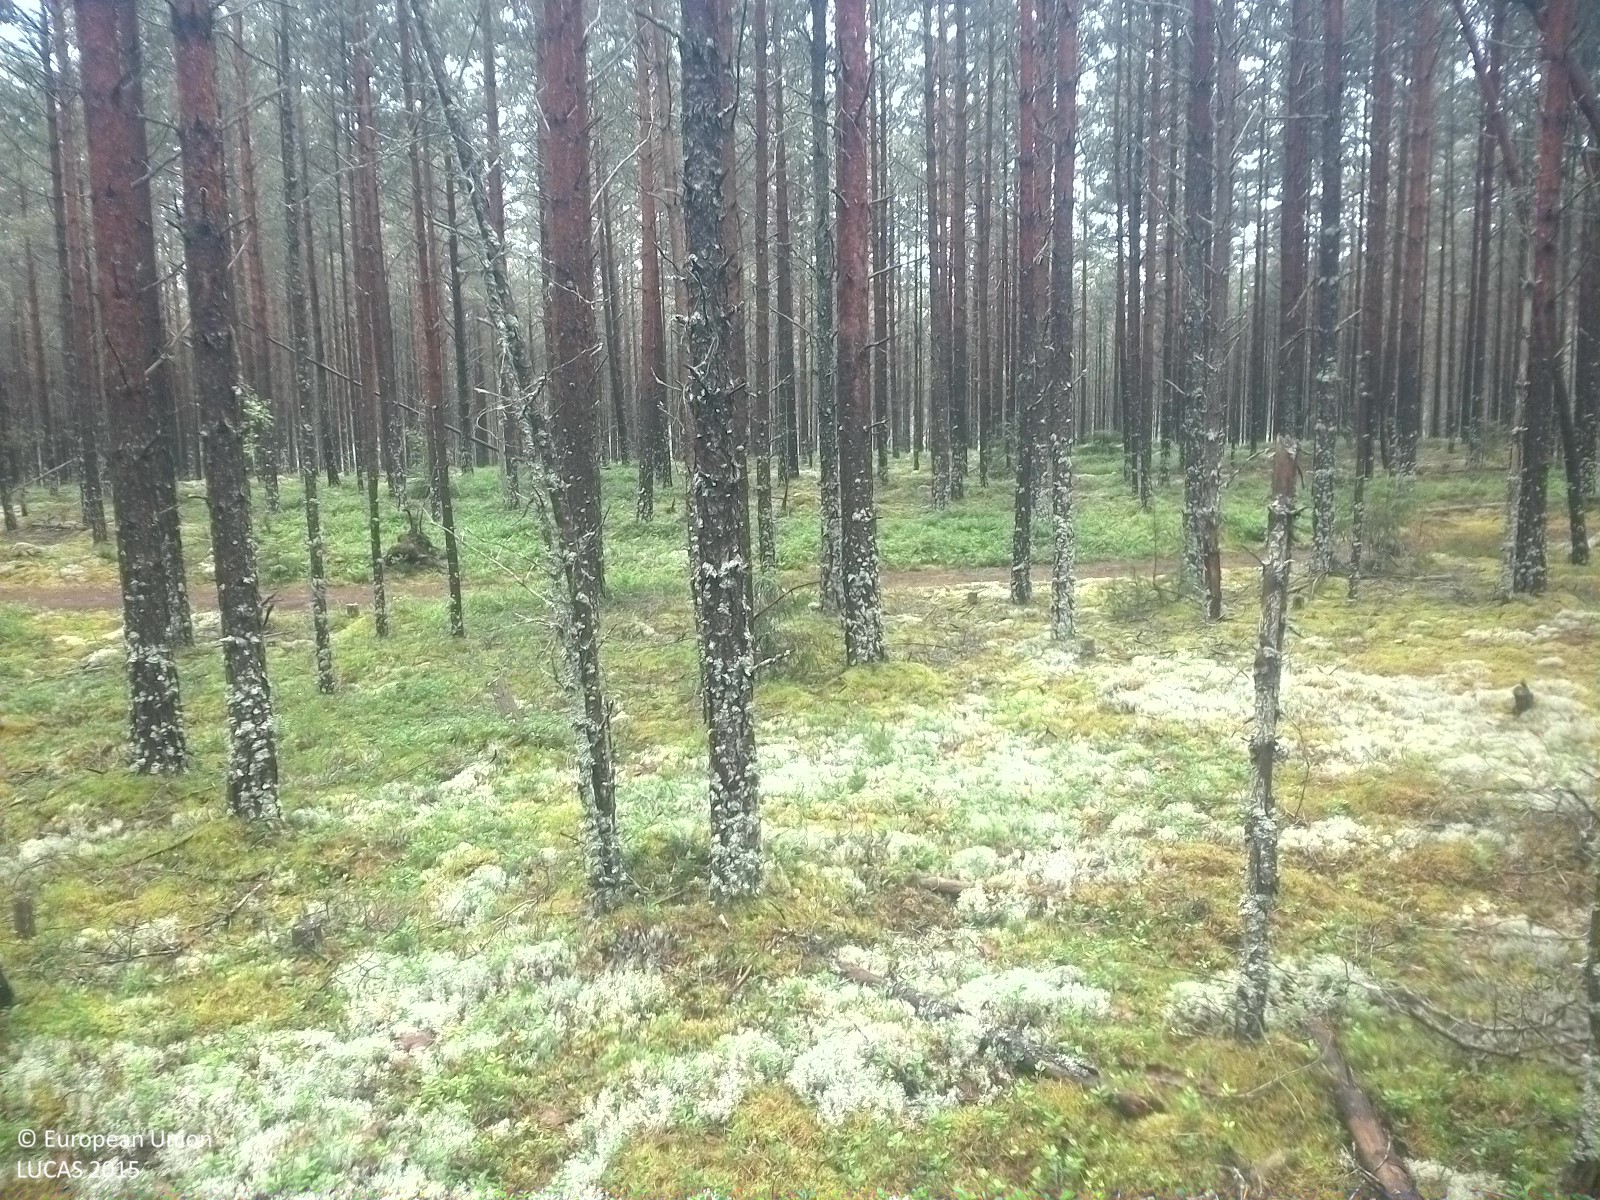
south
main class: Woodland
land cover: Pine dominated coniferous woodland
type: boreal forest
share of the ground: 25 - 50 %
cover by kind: coniferous forest trees 40 %, lichens and mosses 30 %, herbaceous plants 20 %, shrubs 10 %
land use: Forestry
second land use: Amenities, museums, leisure
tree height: > 5 m
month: July
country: SE
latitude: 58.9168
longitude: 15.0807
